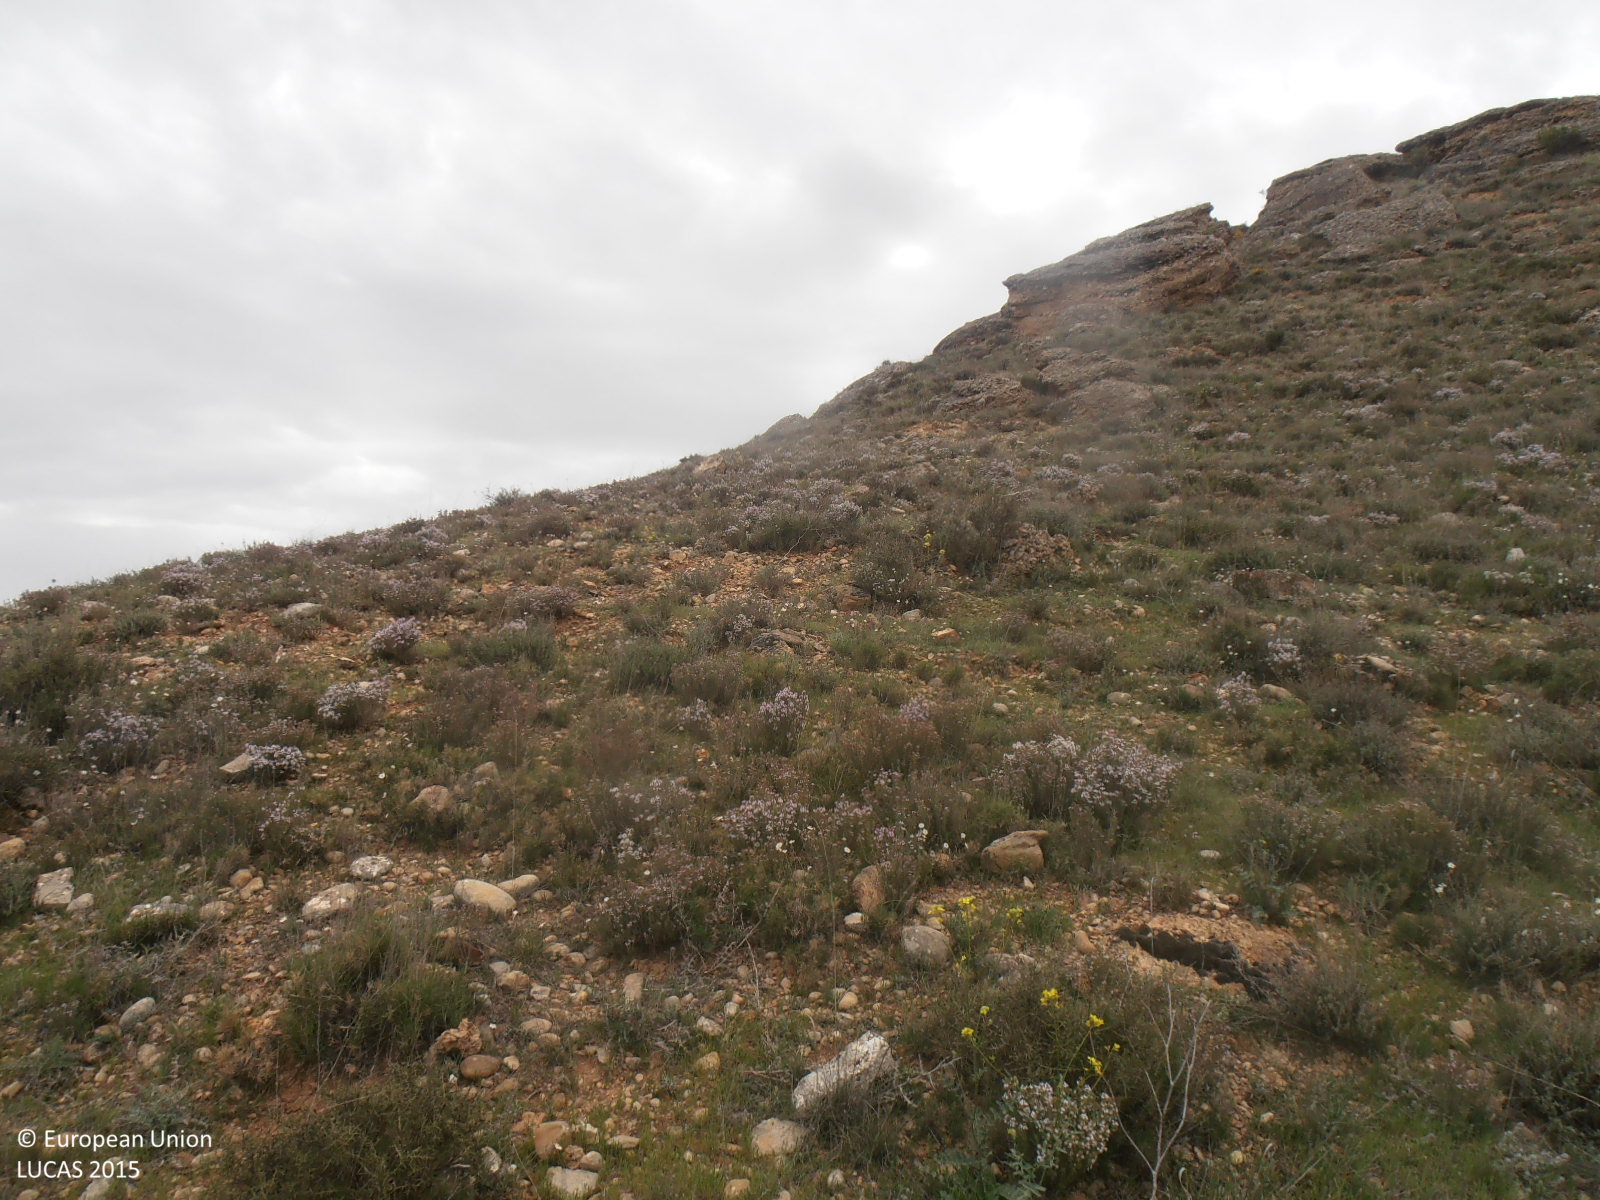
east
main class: Shrubland
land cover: Shrubland without tree cover
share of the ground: > 75 %
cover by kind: shrubs 70 %, herbaceous plants 15 %, consolidated bare surface 15 %
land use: Semi-natural and natural areas not in use
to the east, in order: Shrubland without tree cover; Rock outcrops; Shrubland without tree cover
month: April
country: ES
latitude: 41.2273
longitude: -0.3812
